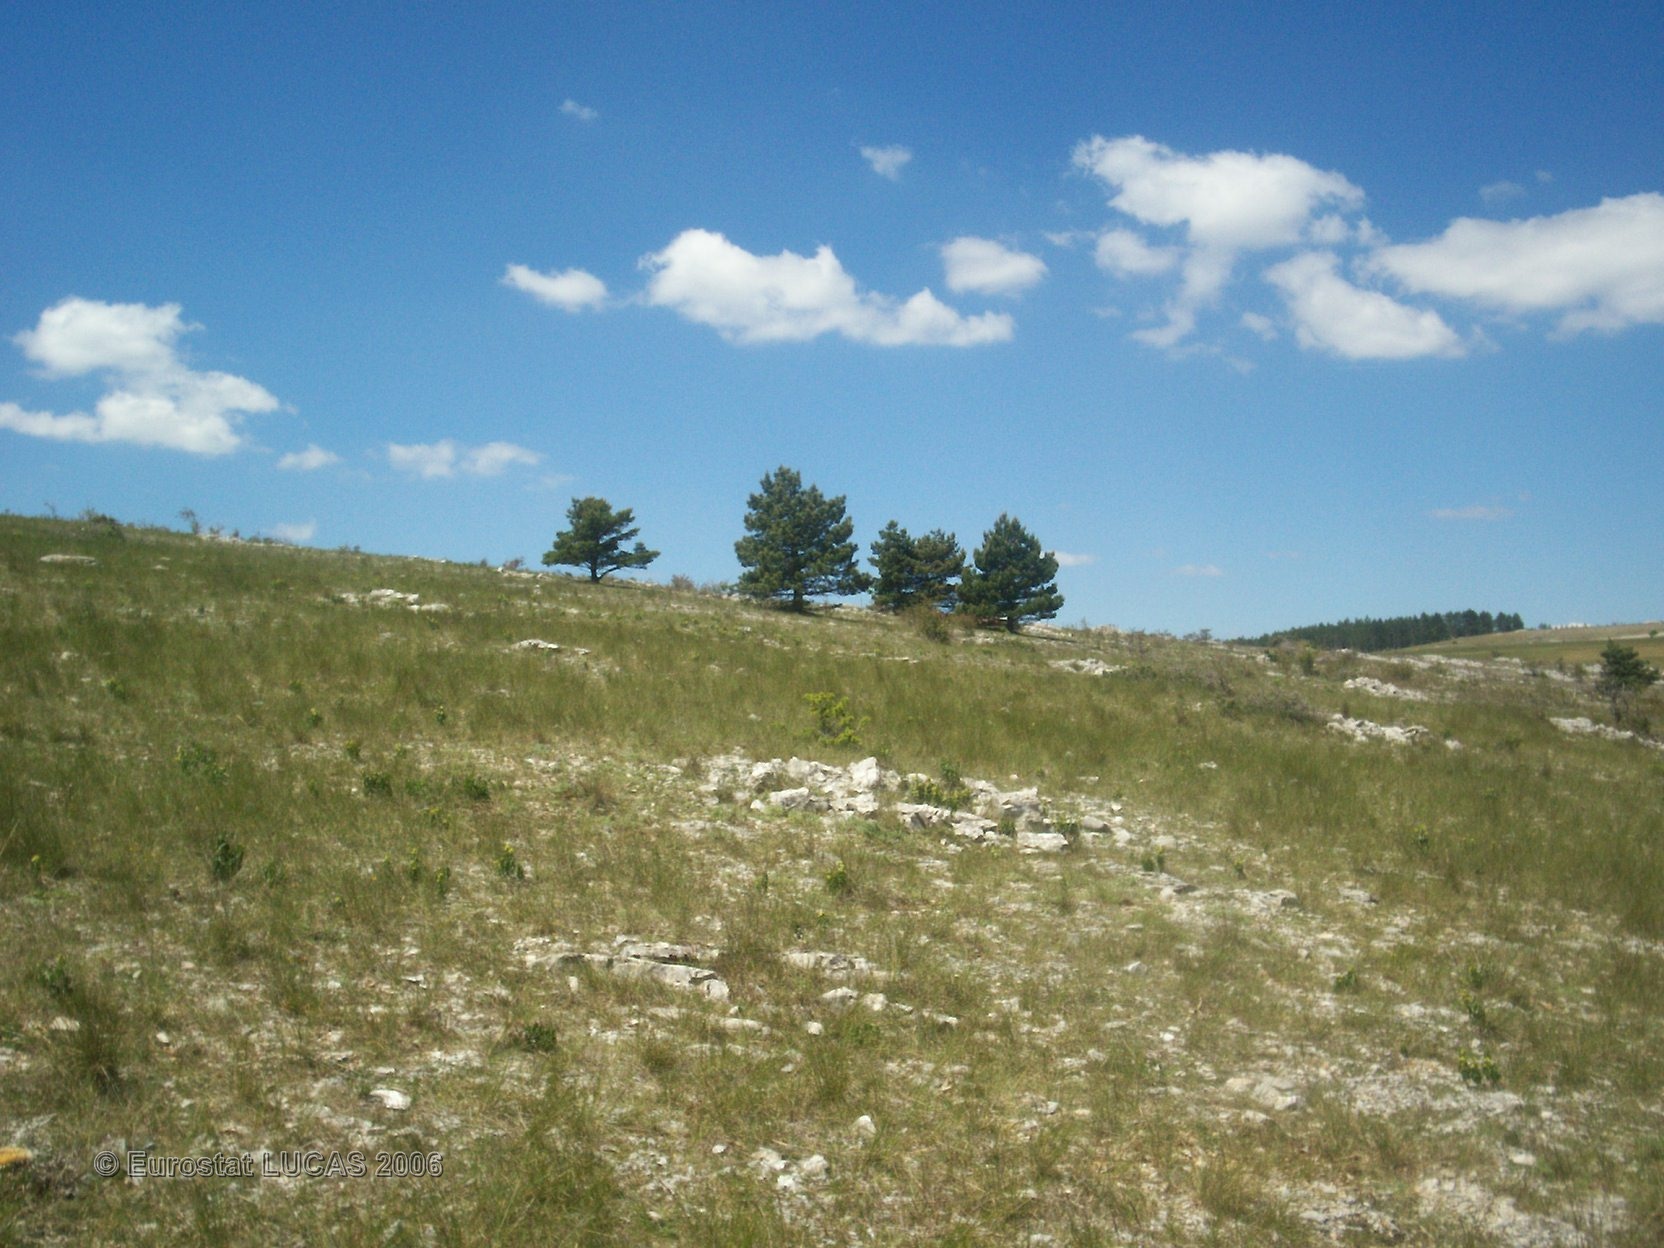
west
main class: Grassland
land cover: Grassland without tree/shrub cover
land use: Agriculture (excluding fallow land and kitchen gardens)
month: June
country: FR
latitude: 44.2134
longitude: 3.4103
